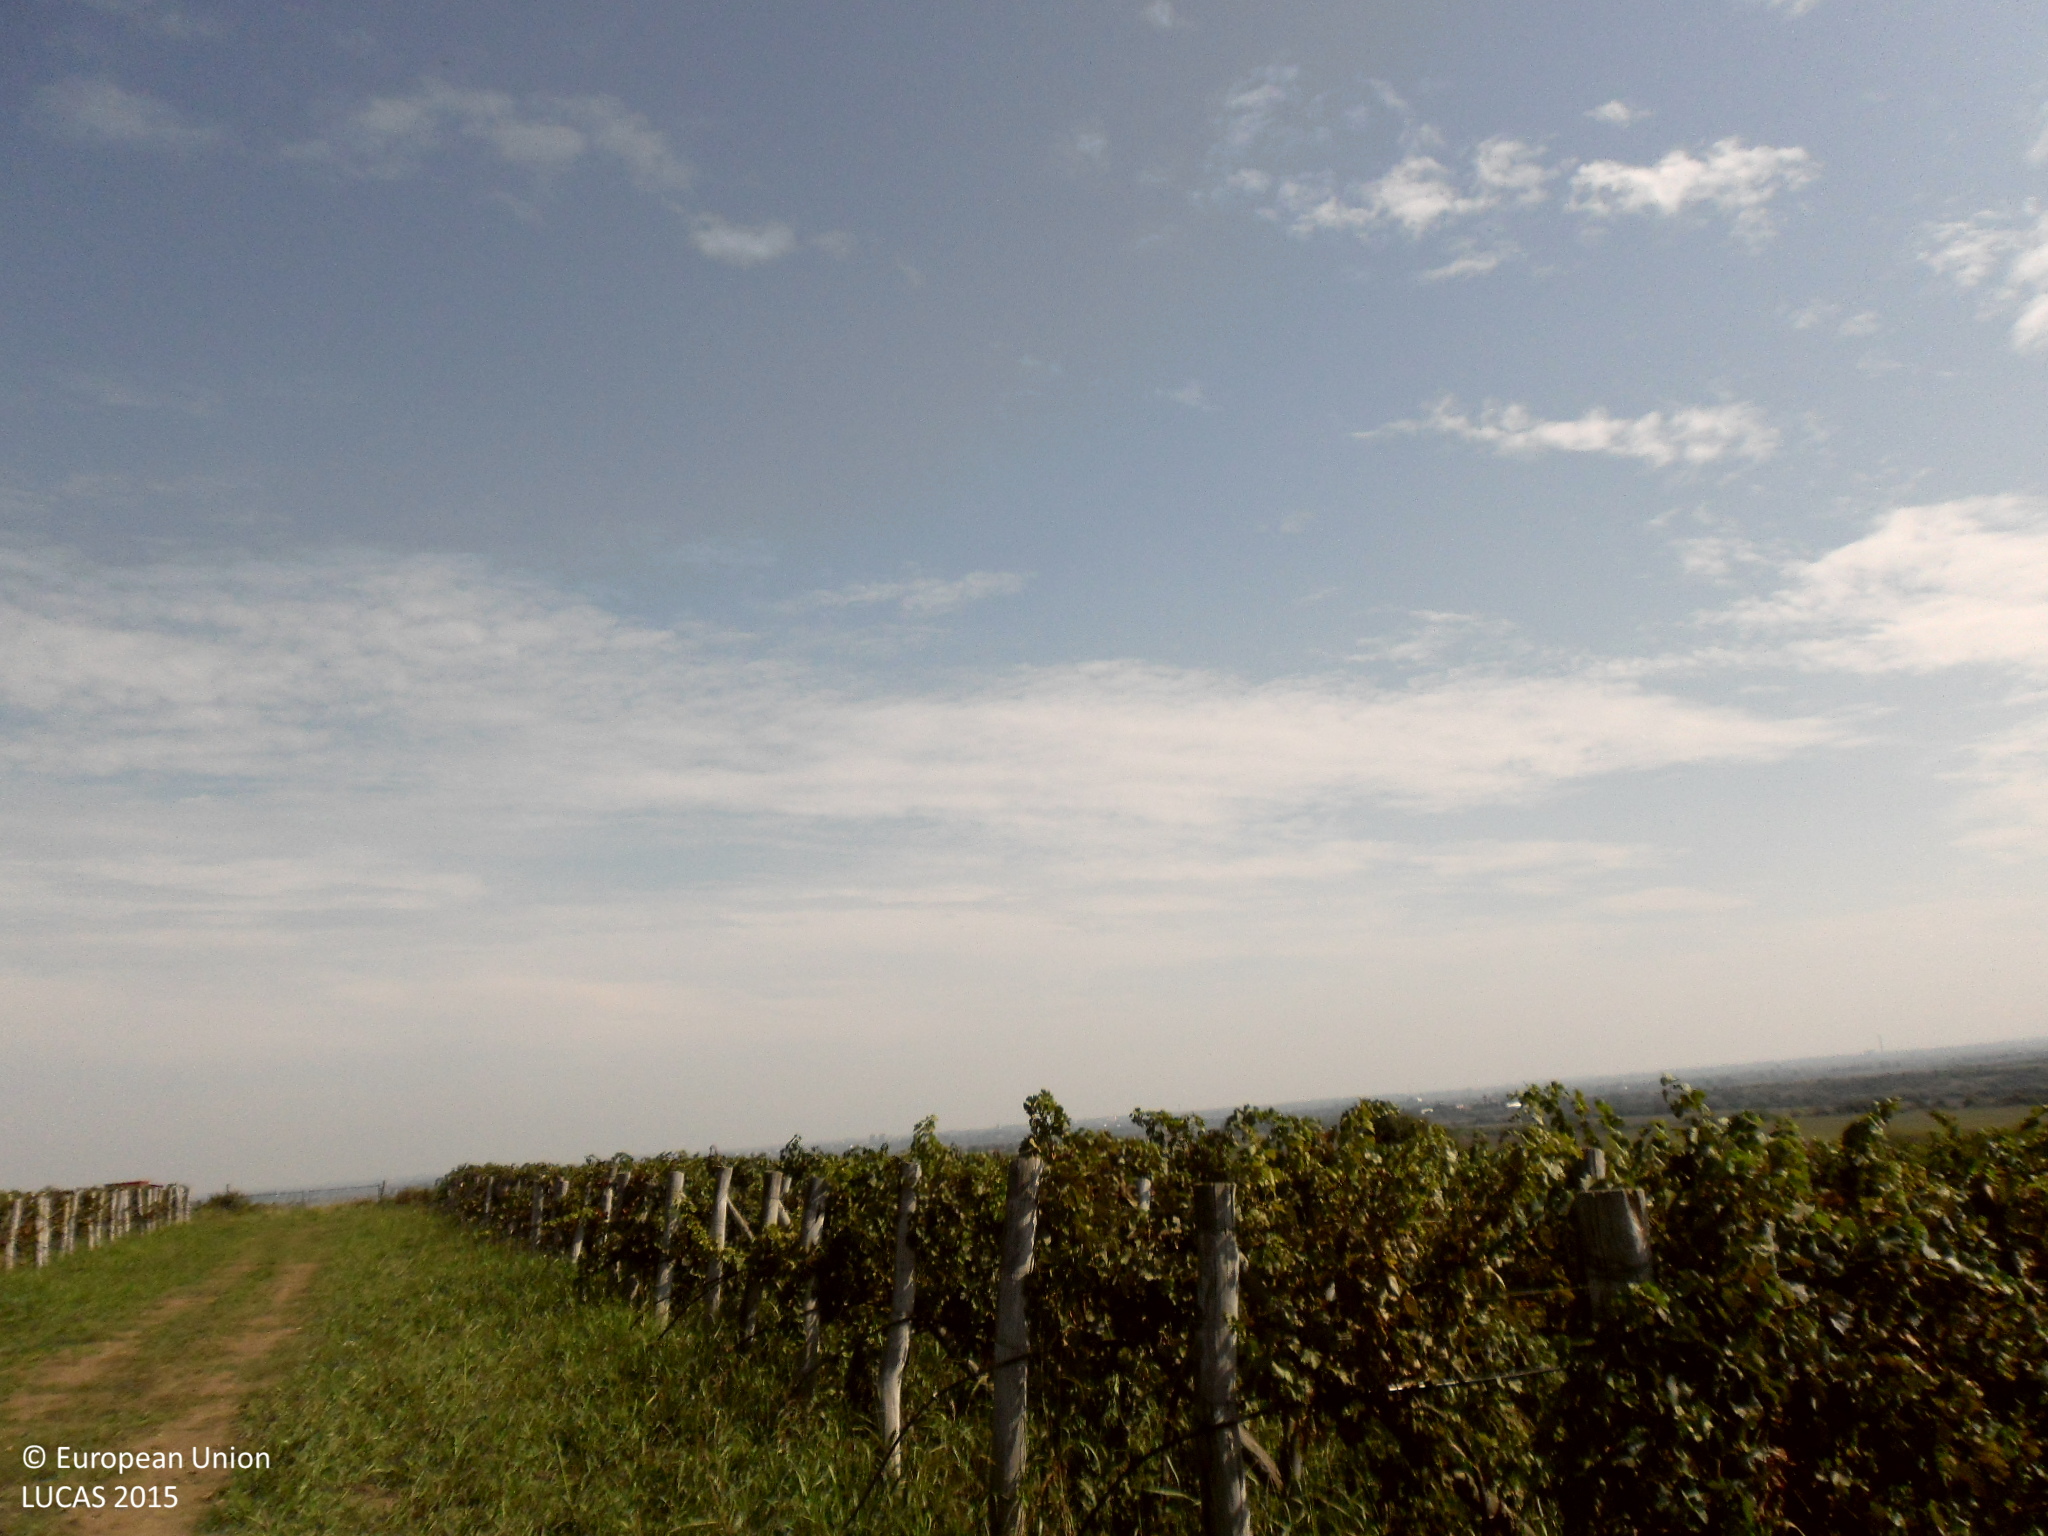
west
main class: Artificial land
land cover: Non built-up linear features
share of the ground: > 75 %
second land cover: Grassland without tree/shrub cover
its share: 25 - 50 %
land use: Road transport
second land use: Agriculture (excluding fallow land and kitchen gardens)
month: October
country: BG
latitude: 44.0135
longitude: 22.7740
